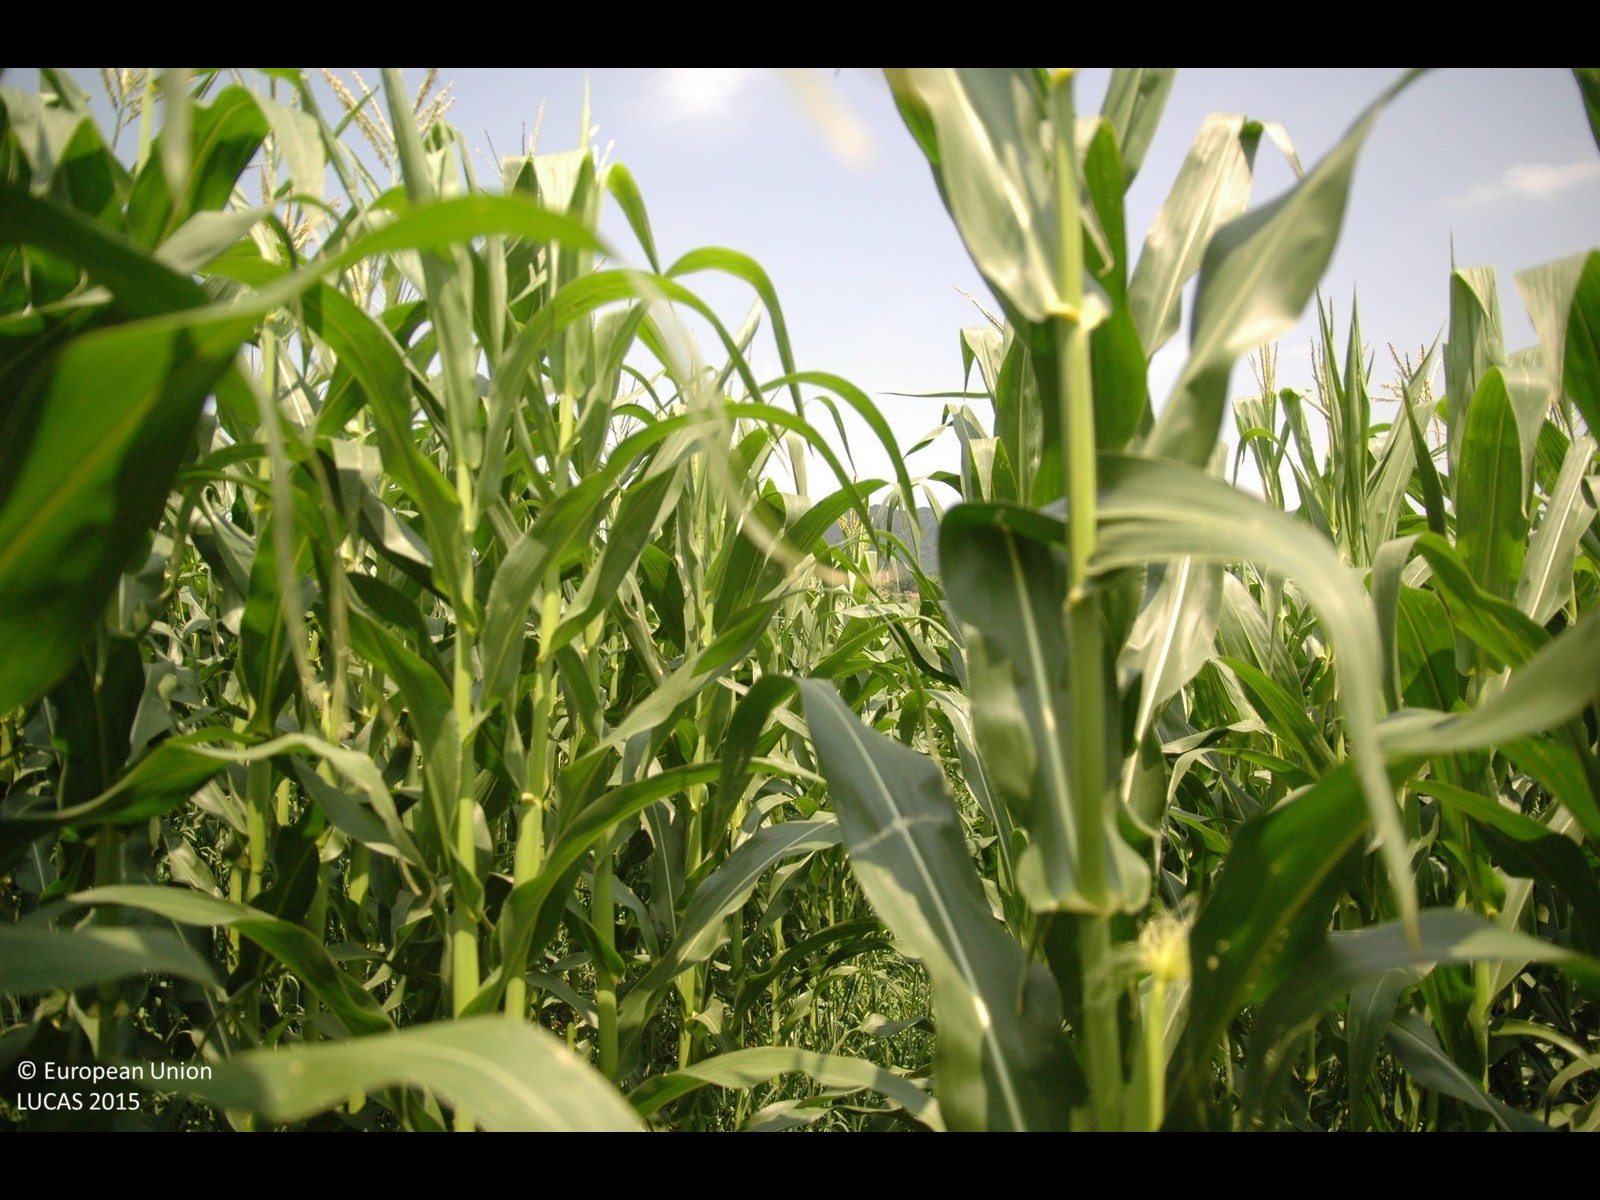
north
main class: Cropland
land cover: Maize
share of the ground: > 75 %
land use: Agriculture (excluding fallow land and kitchen gardens)
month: July
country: HR
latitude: 46.1412
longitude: 16.0963
